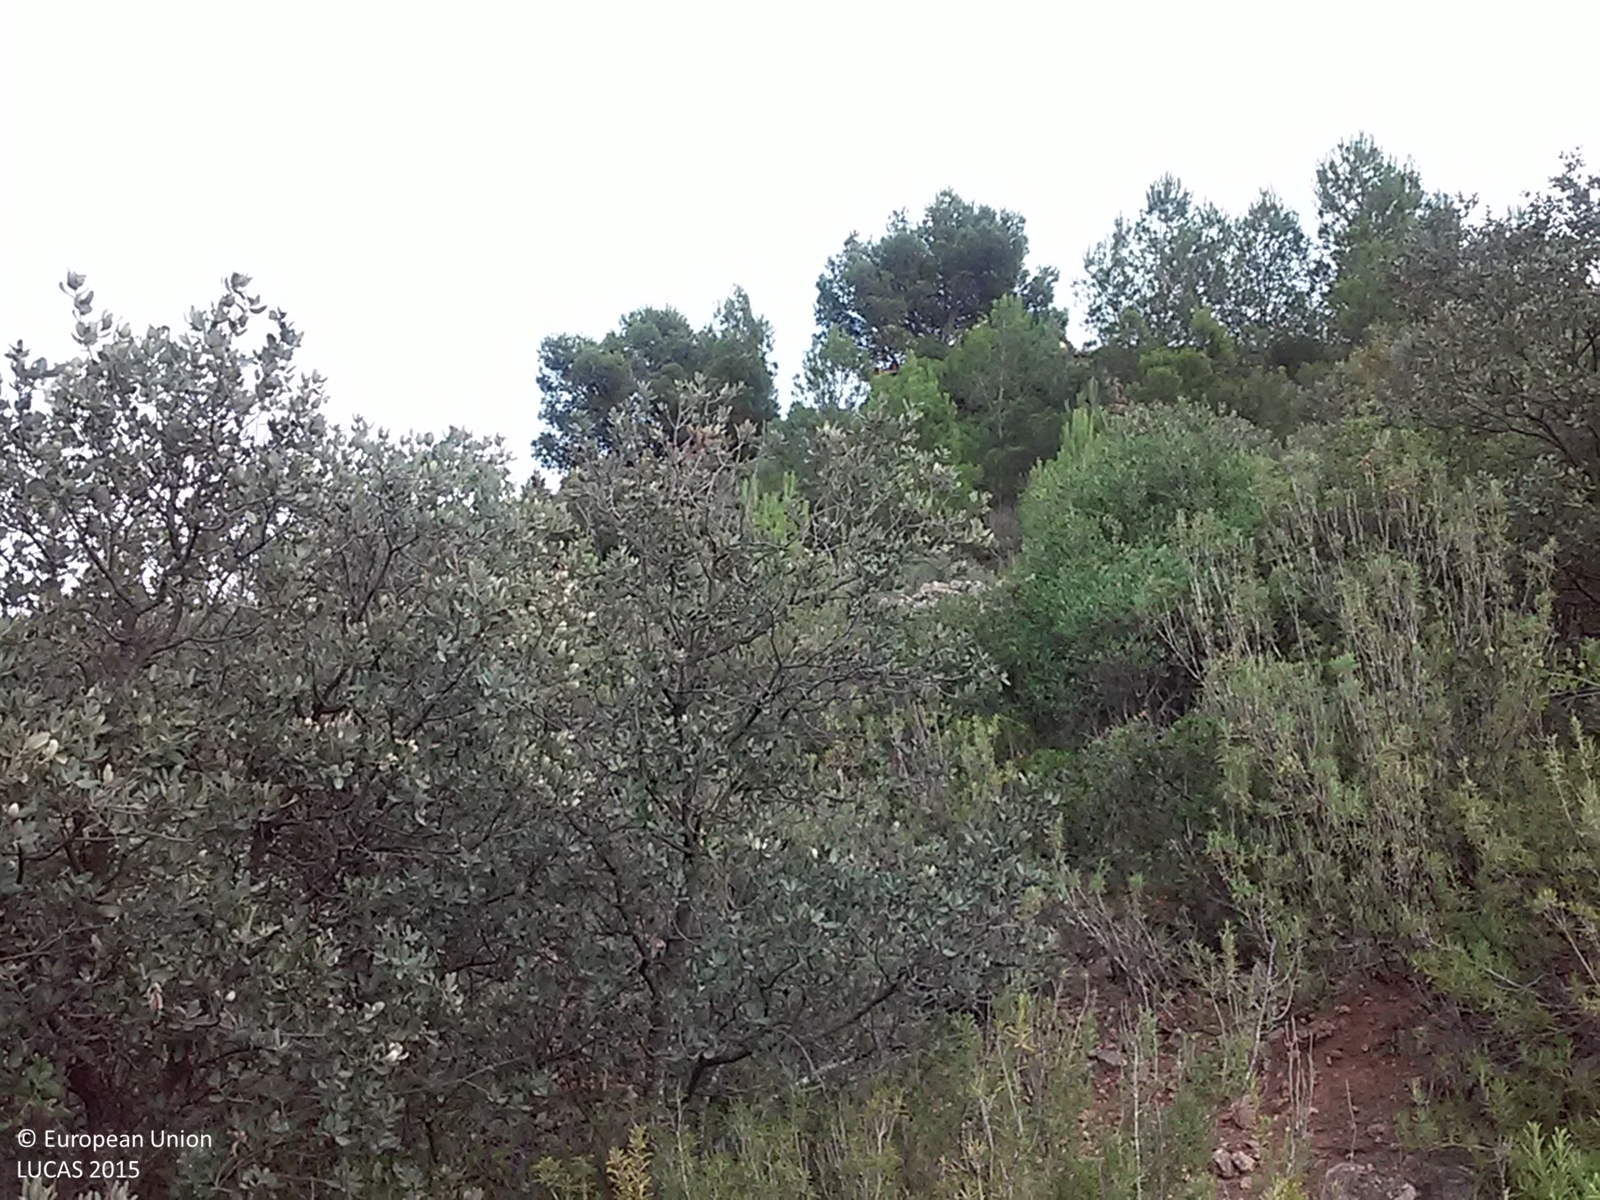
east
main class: Shrubland
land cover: Shrubland with sparse tree cover
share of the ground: > 75 %
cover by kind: shrubs 95 %, broadleaved forest trees 5 %
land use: Semi-natural and natural areas not in use
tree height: < 5 m
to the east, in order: Shrubland with sparse tree cover; Tracks; Shrubland with sparse tree cover; Tracks; Shrubland with sparse tree cover; Tracks; Shrubland with sparse tree cover; Rock outcrops; Shrubland with sparse tree cover; Rock outcrops; Shrubland with sparse tree cover
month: September
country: ES
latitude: 41.2522
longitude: 0.7901
